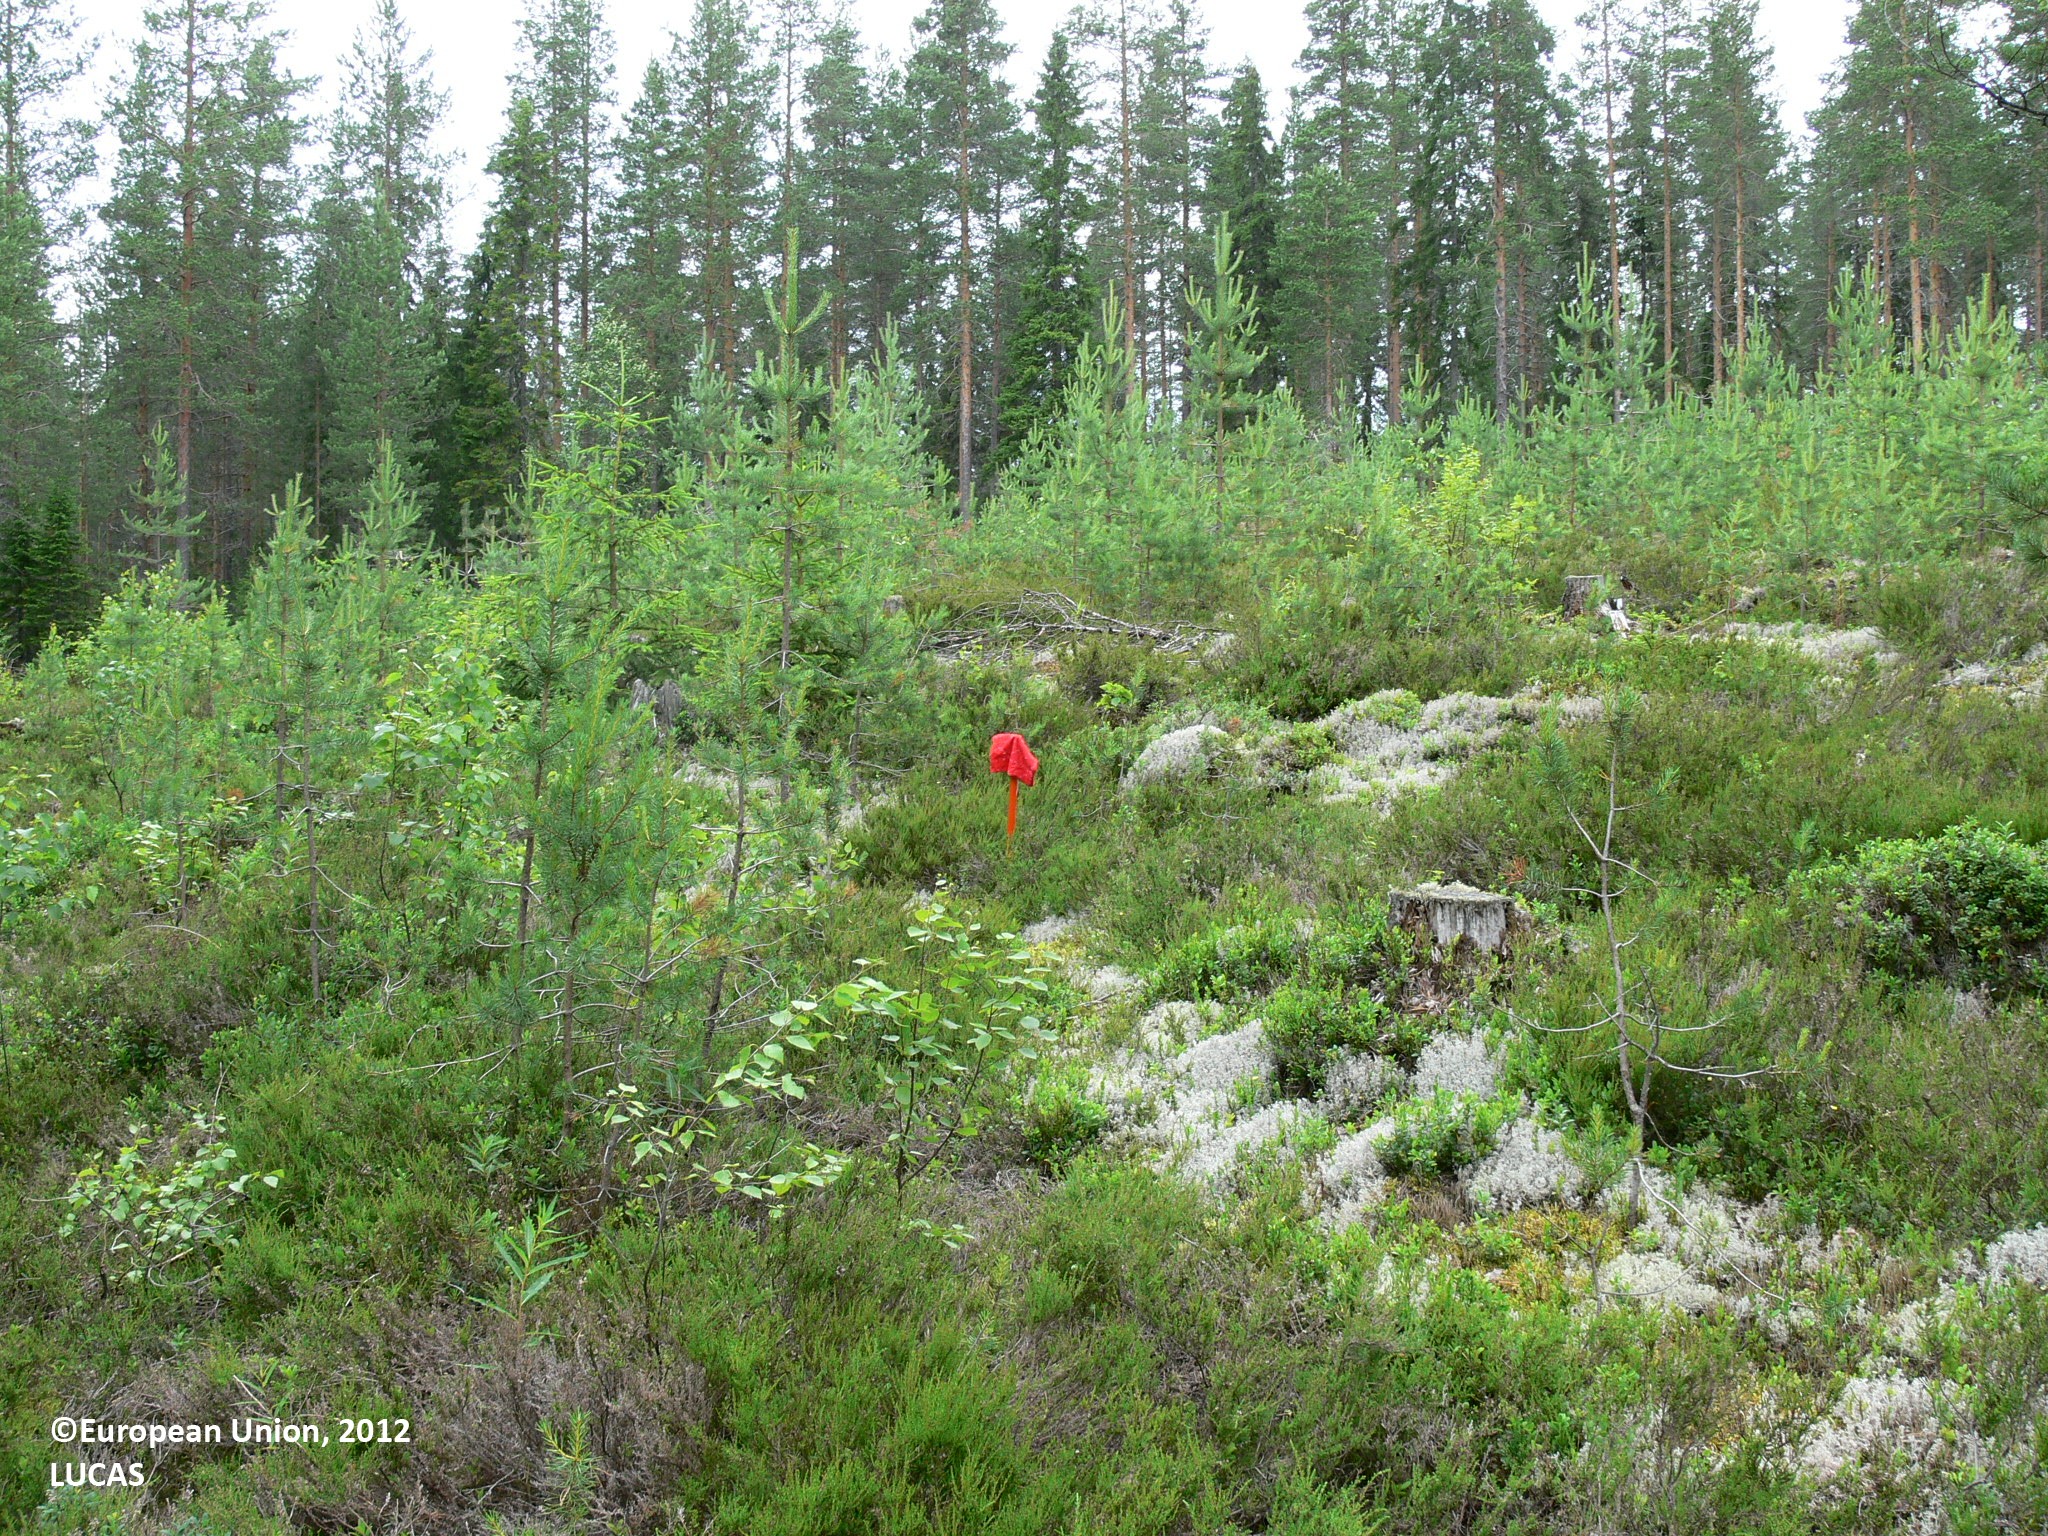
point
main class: Woodland
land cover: Pine dominated coniferous woodland
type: boreal forest
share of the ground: 25 - 50 %
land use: Forestry
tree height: < 5 m
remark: Clear cut
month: July
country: FI
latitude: 63.2578
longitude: 30.7830
